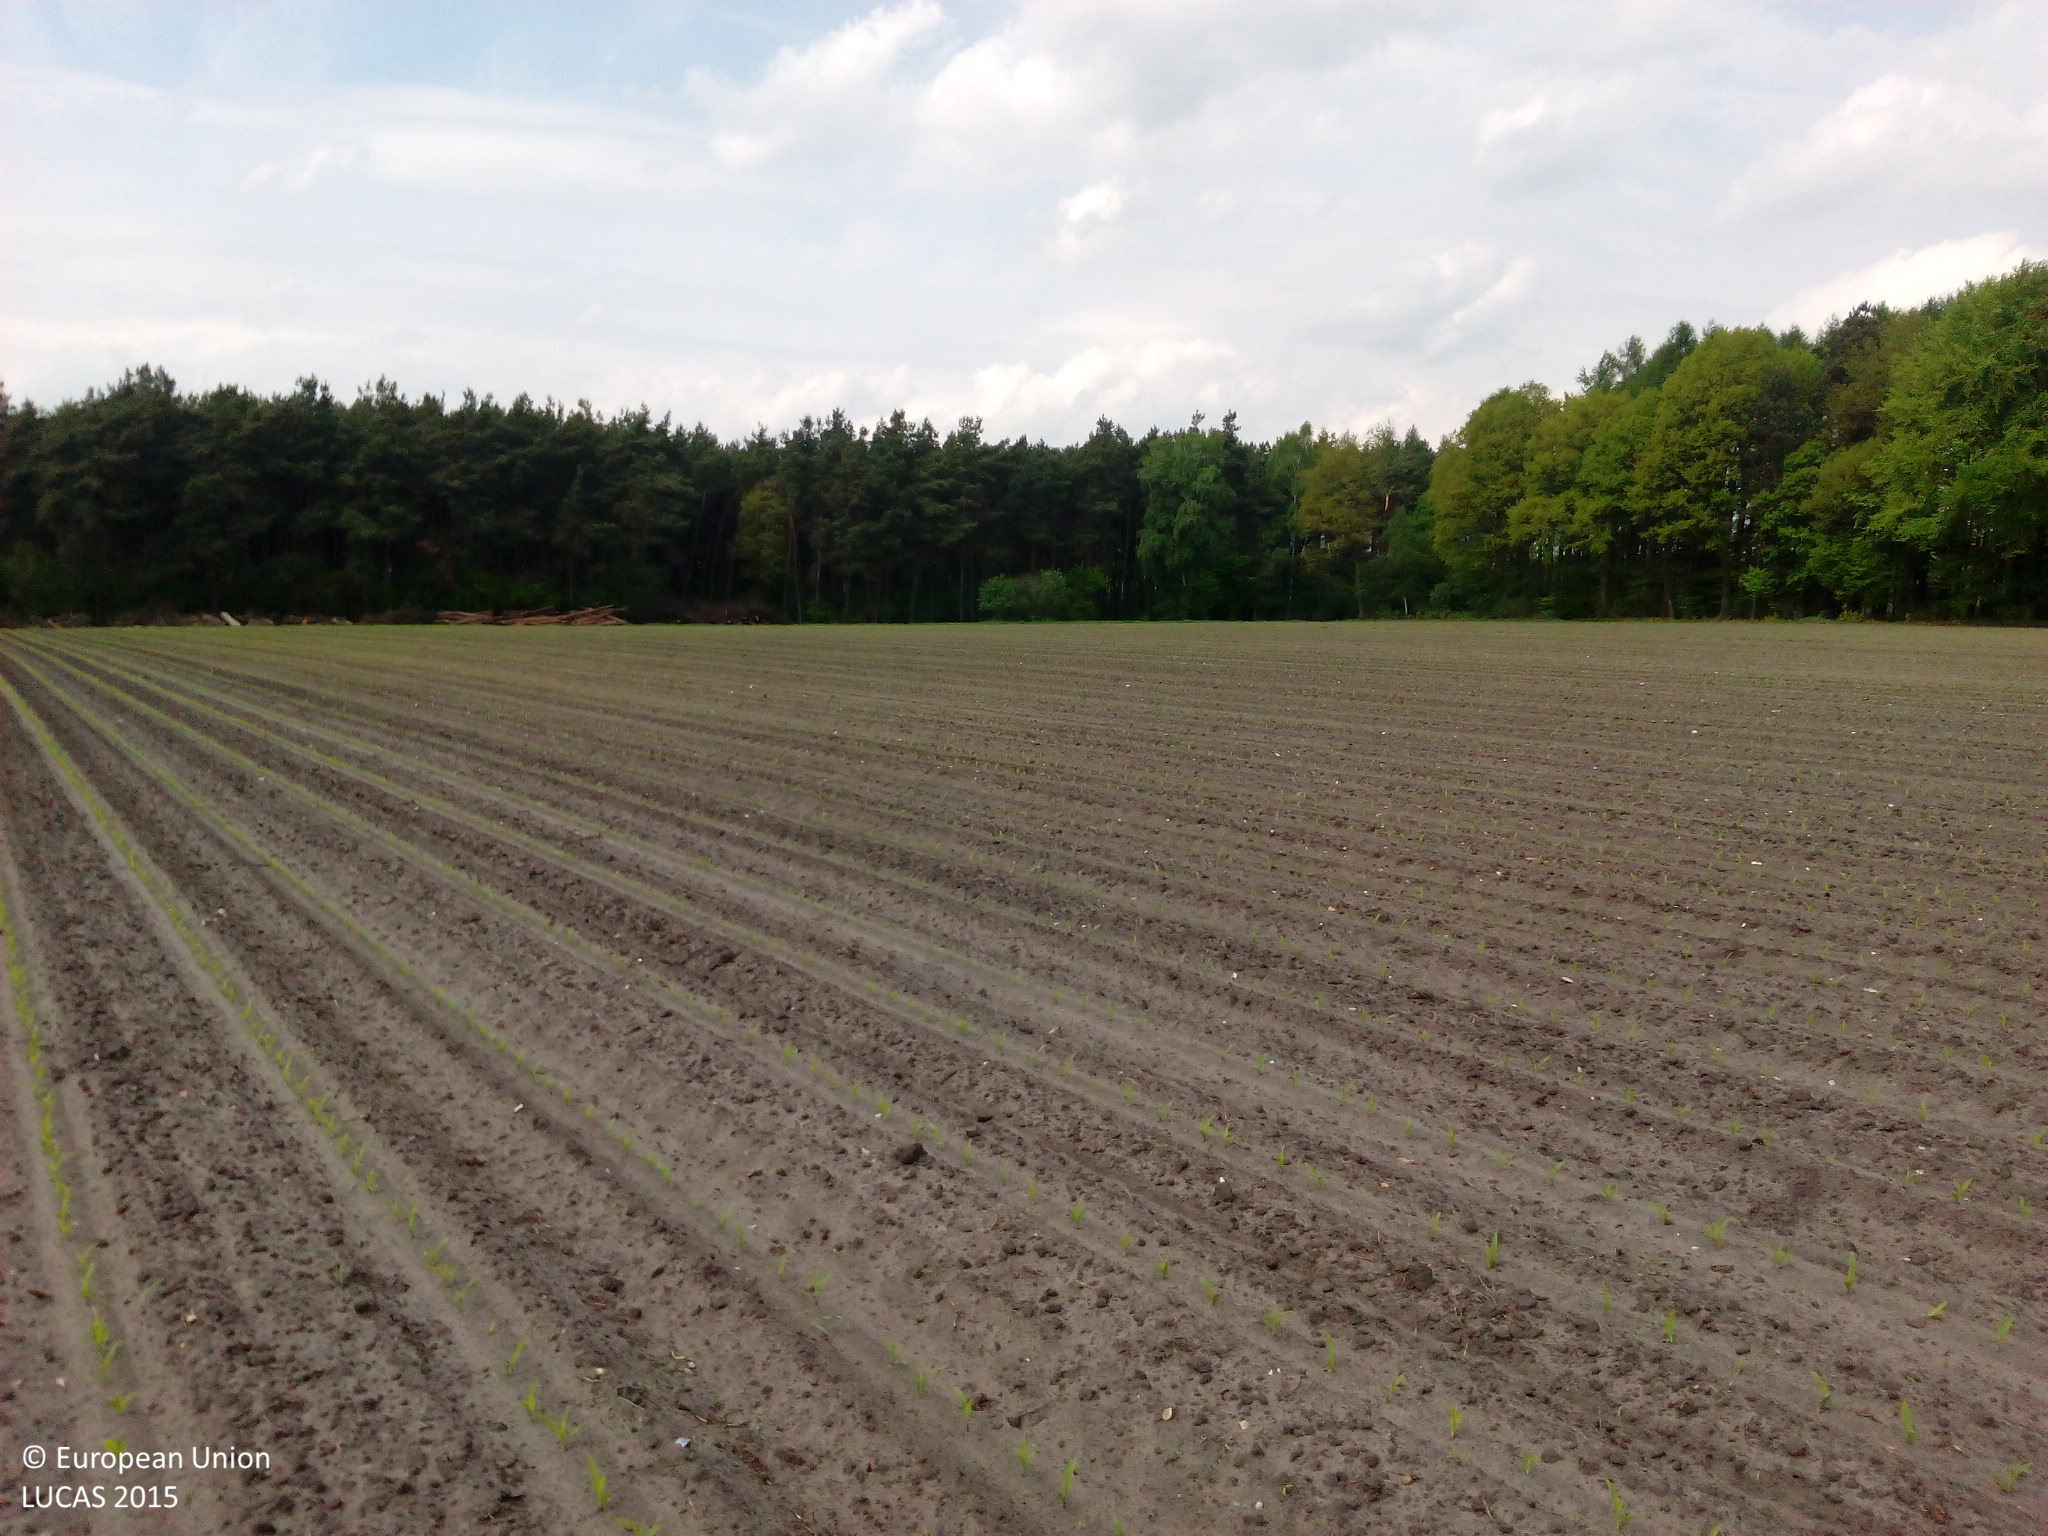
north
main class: Cropland
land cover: Maize
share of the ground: < 10 %
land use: Agriculture (excluding fallow land and kitchen gardens)
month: May
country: DE
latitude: 53.2733
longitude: 9.1756
